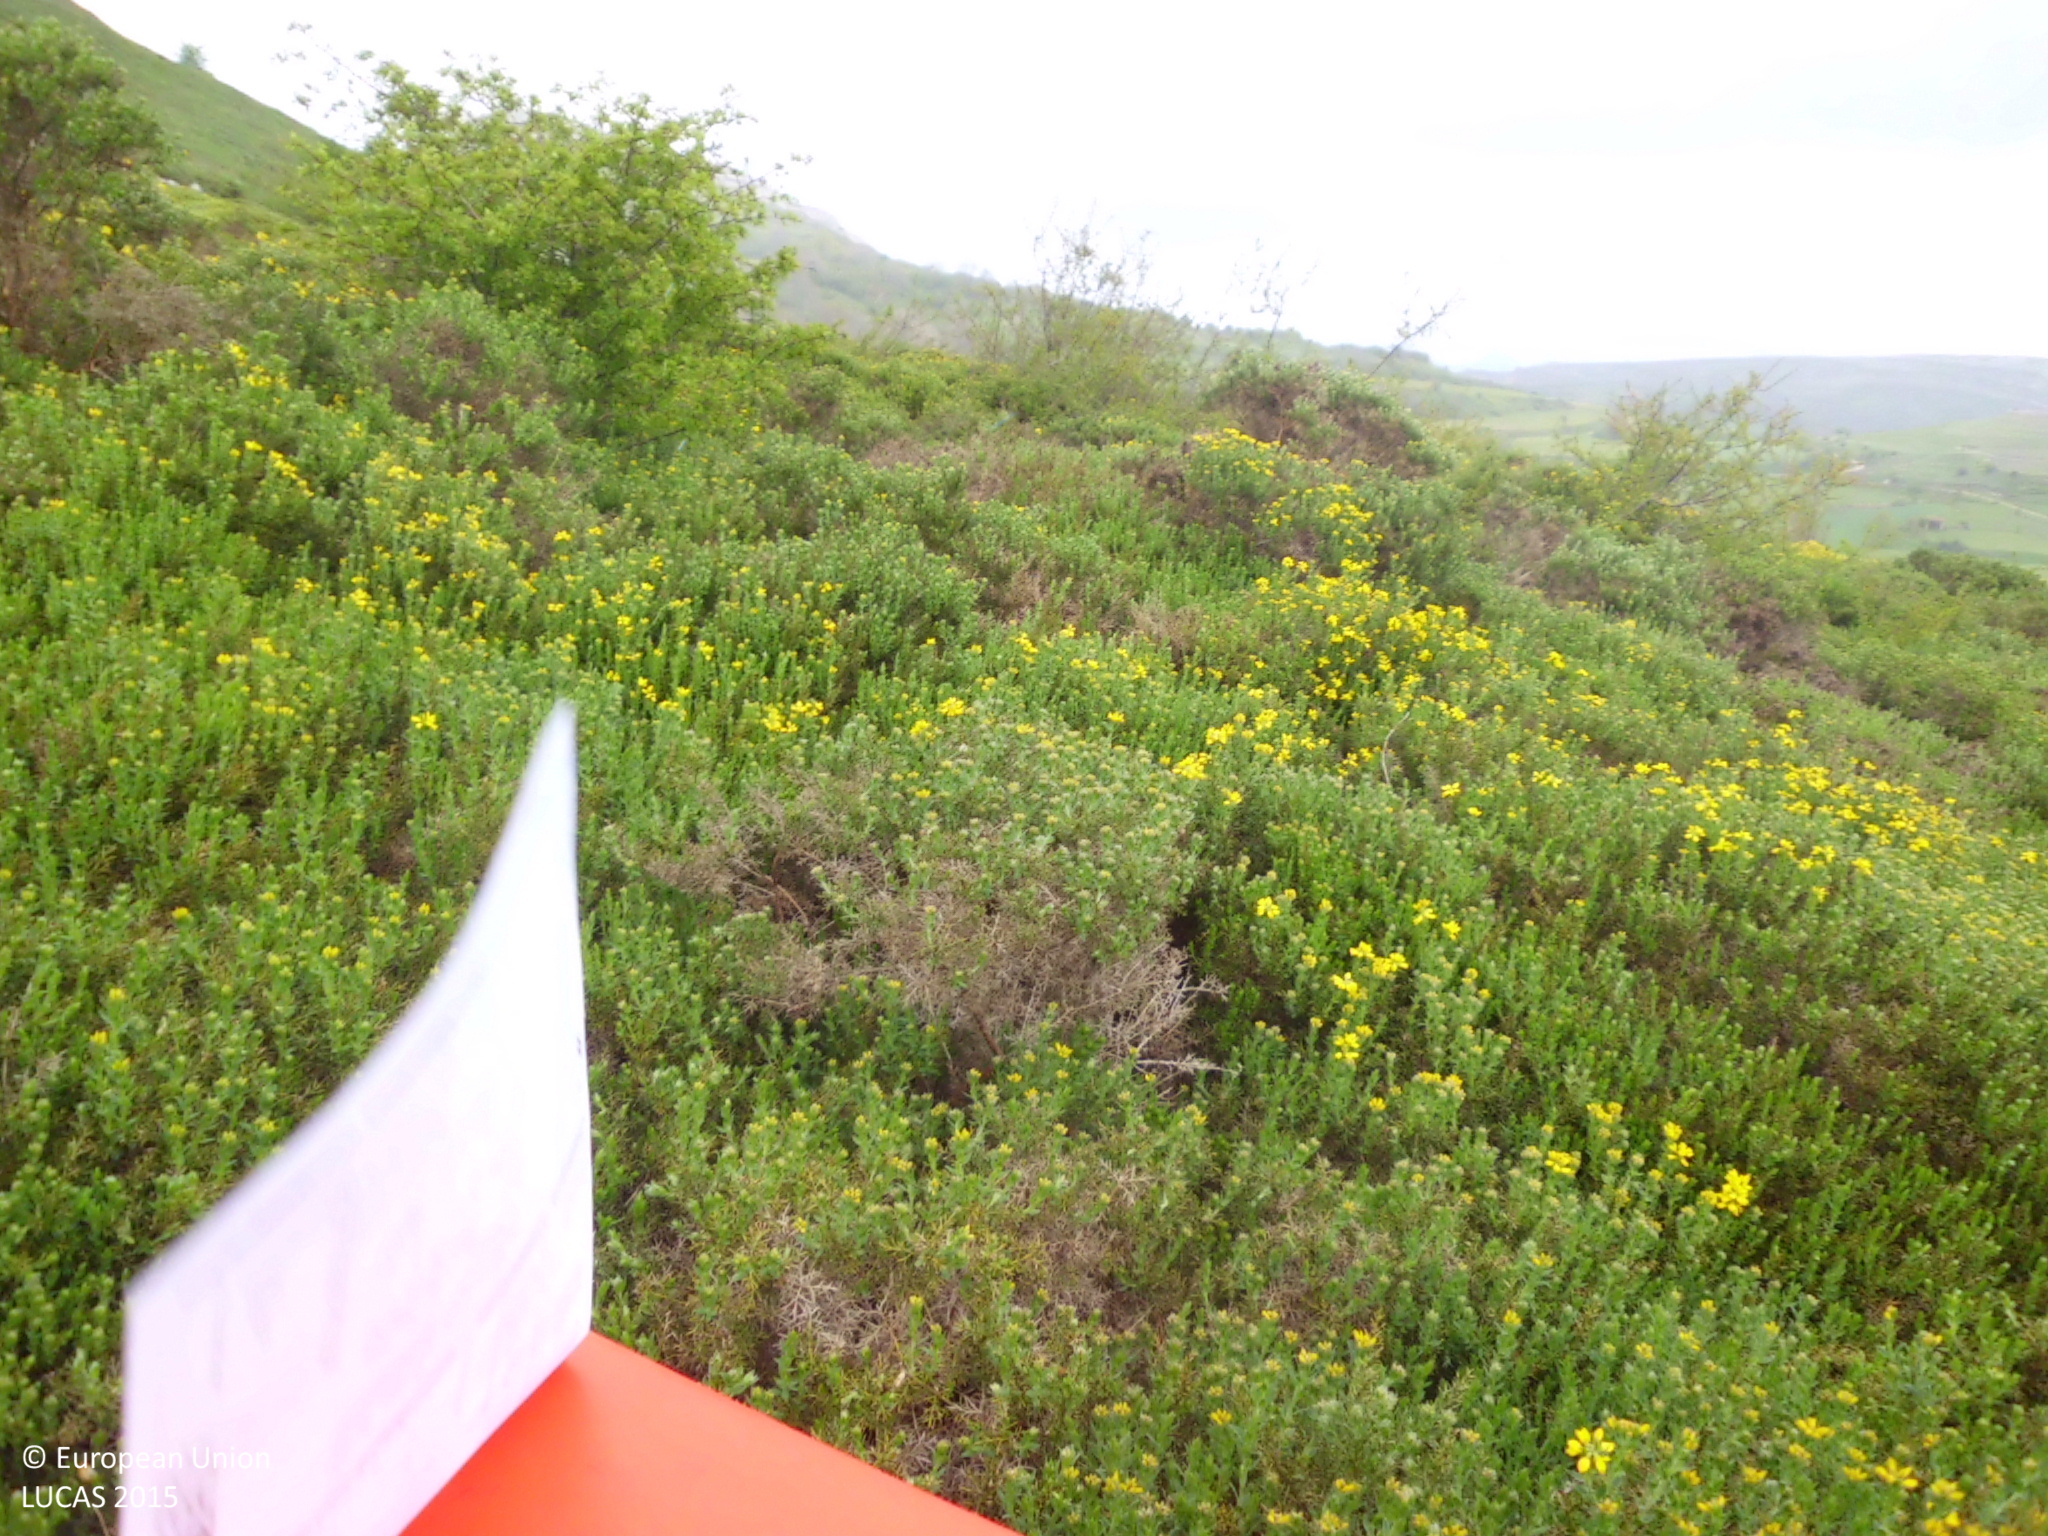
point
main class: Shrubland
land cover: Shrubland without tree cover
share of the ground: > 75 %
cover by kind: shrubs 80 %, herbaceous plants 20 %
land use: Semi-natural and natural areas not in use
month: May
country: ES
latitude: 42.9050
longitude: -3.8477
